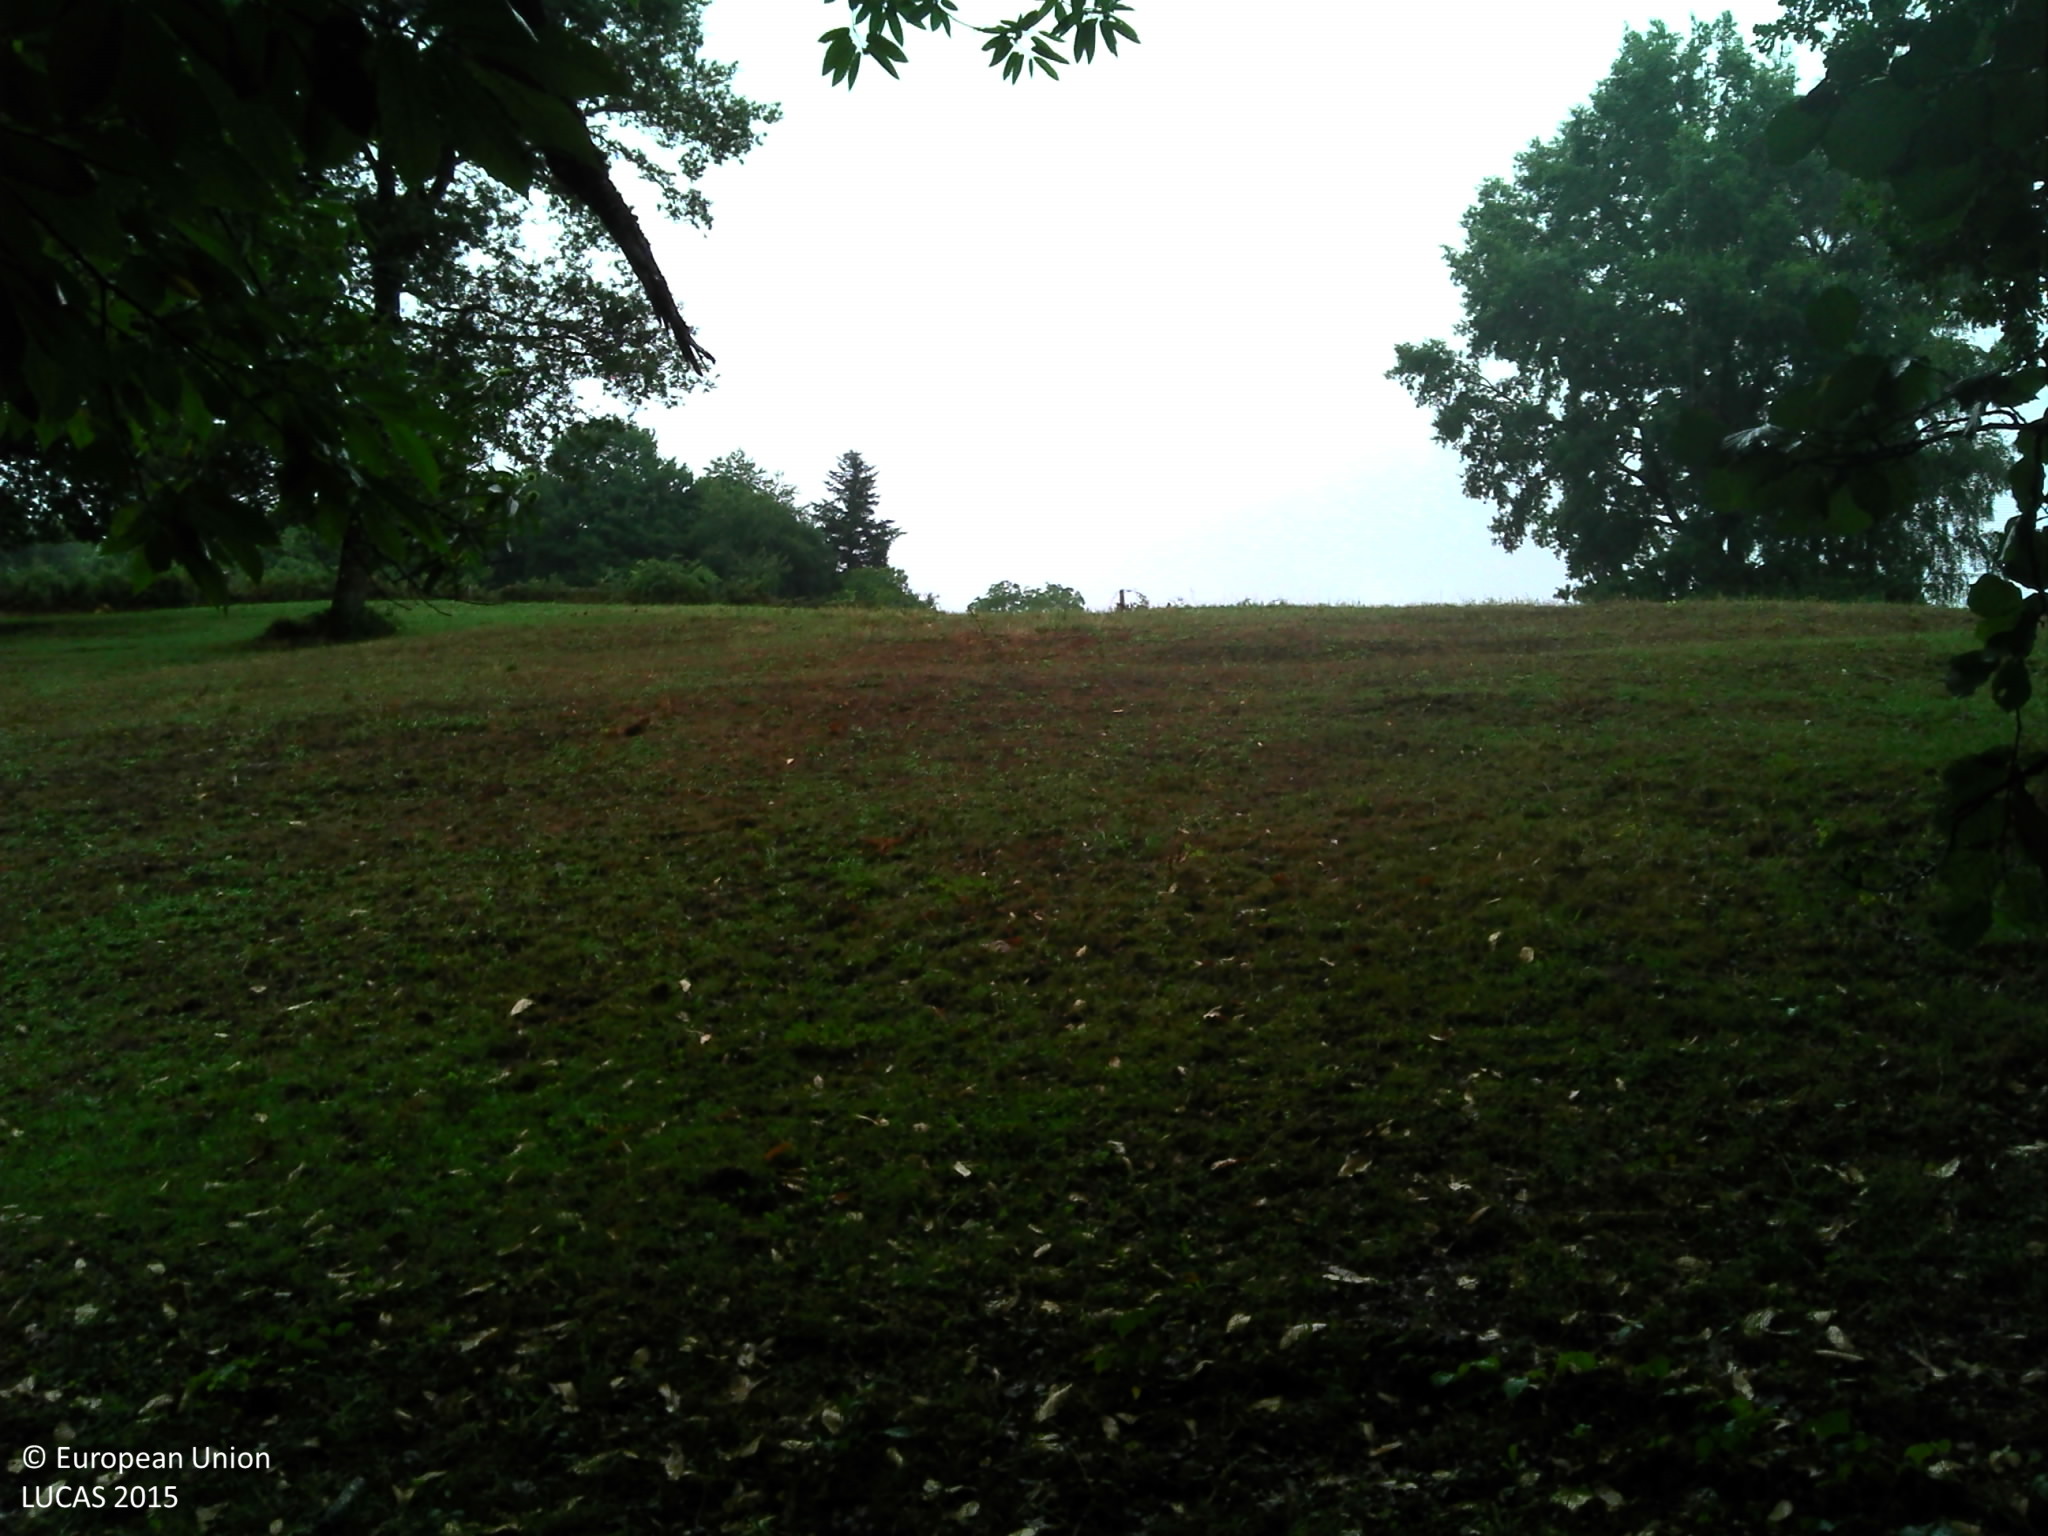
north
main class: Woodland
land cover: Broadleaved woodland
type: mesophytic deciduous forest
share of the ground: 50 - 75 %
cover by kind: broadleaved forest trees 40 %, shrubs 25 %, herbaceous plants 20 %, lichens and mosses 10 %, unconsolidated bare surface 5 %
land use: Forestry
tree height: > 5 m
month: August
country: FR
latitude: 45.4345
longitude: 1.0818
